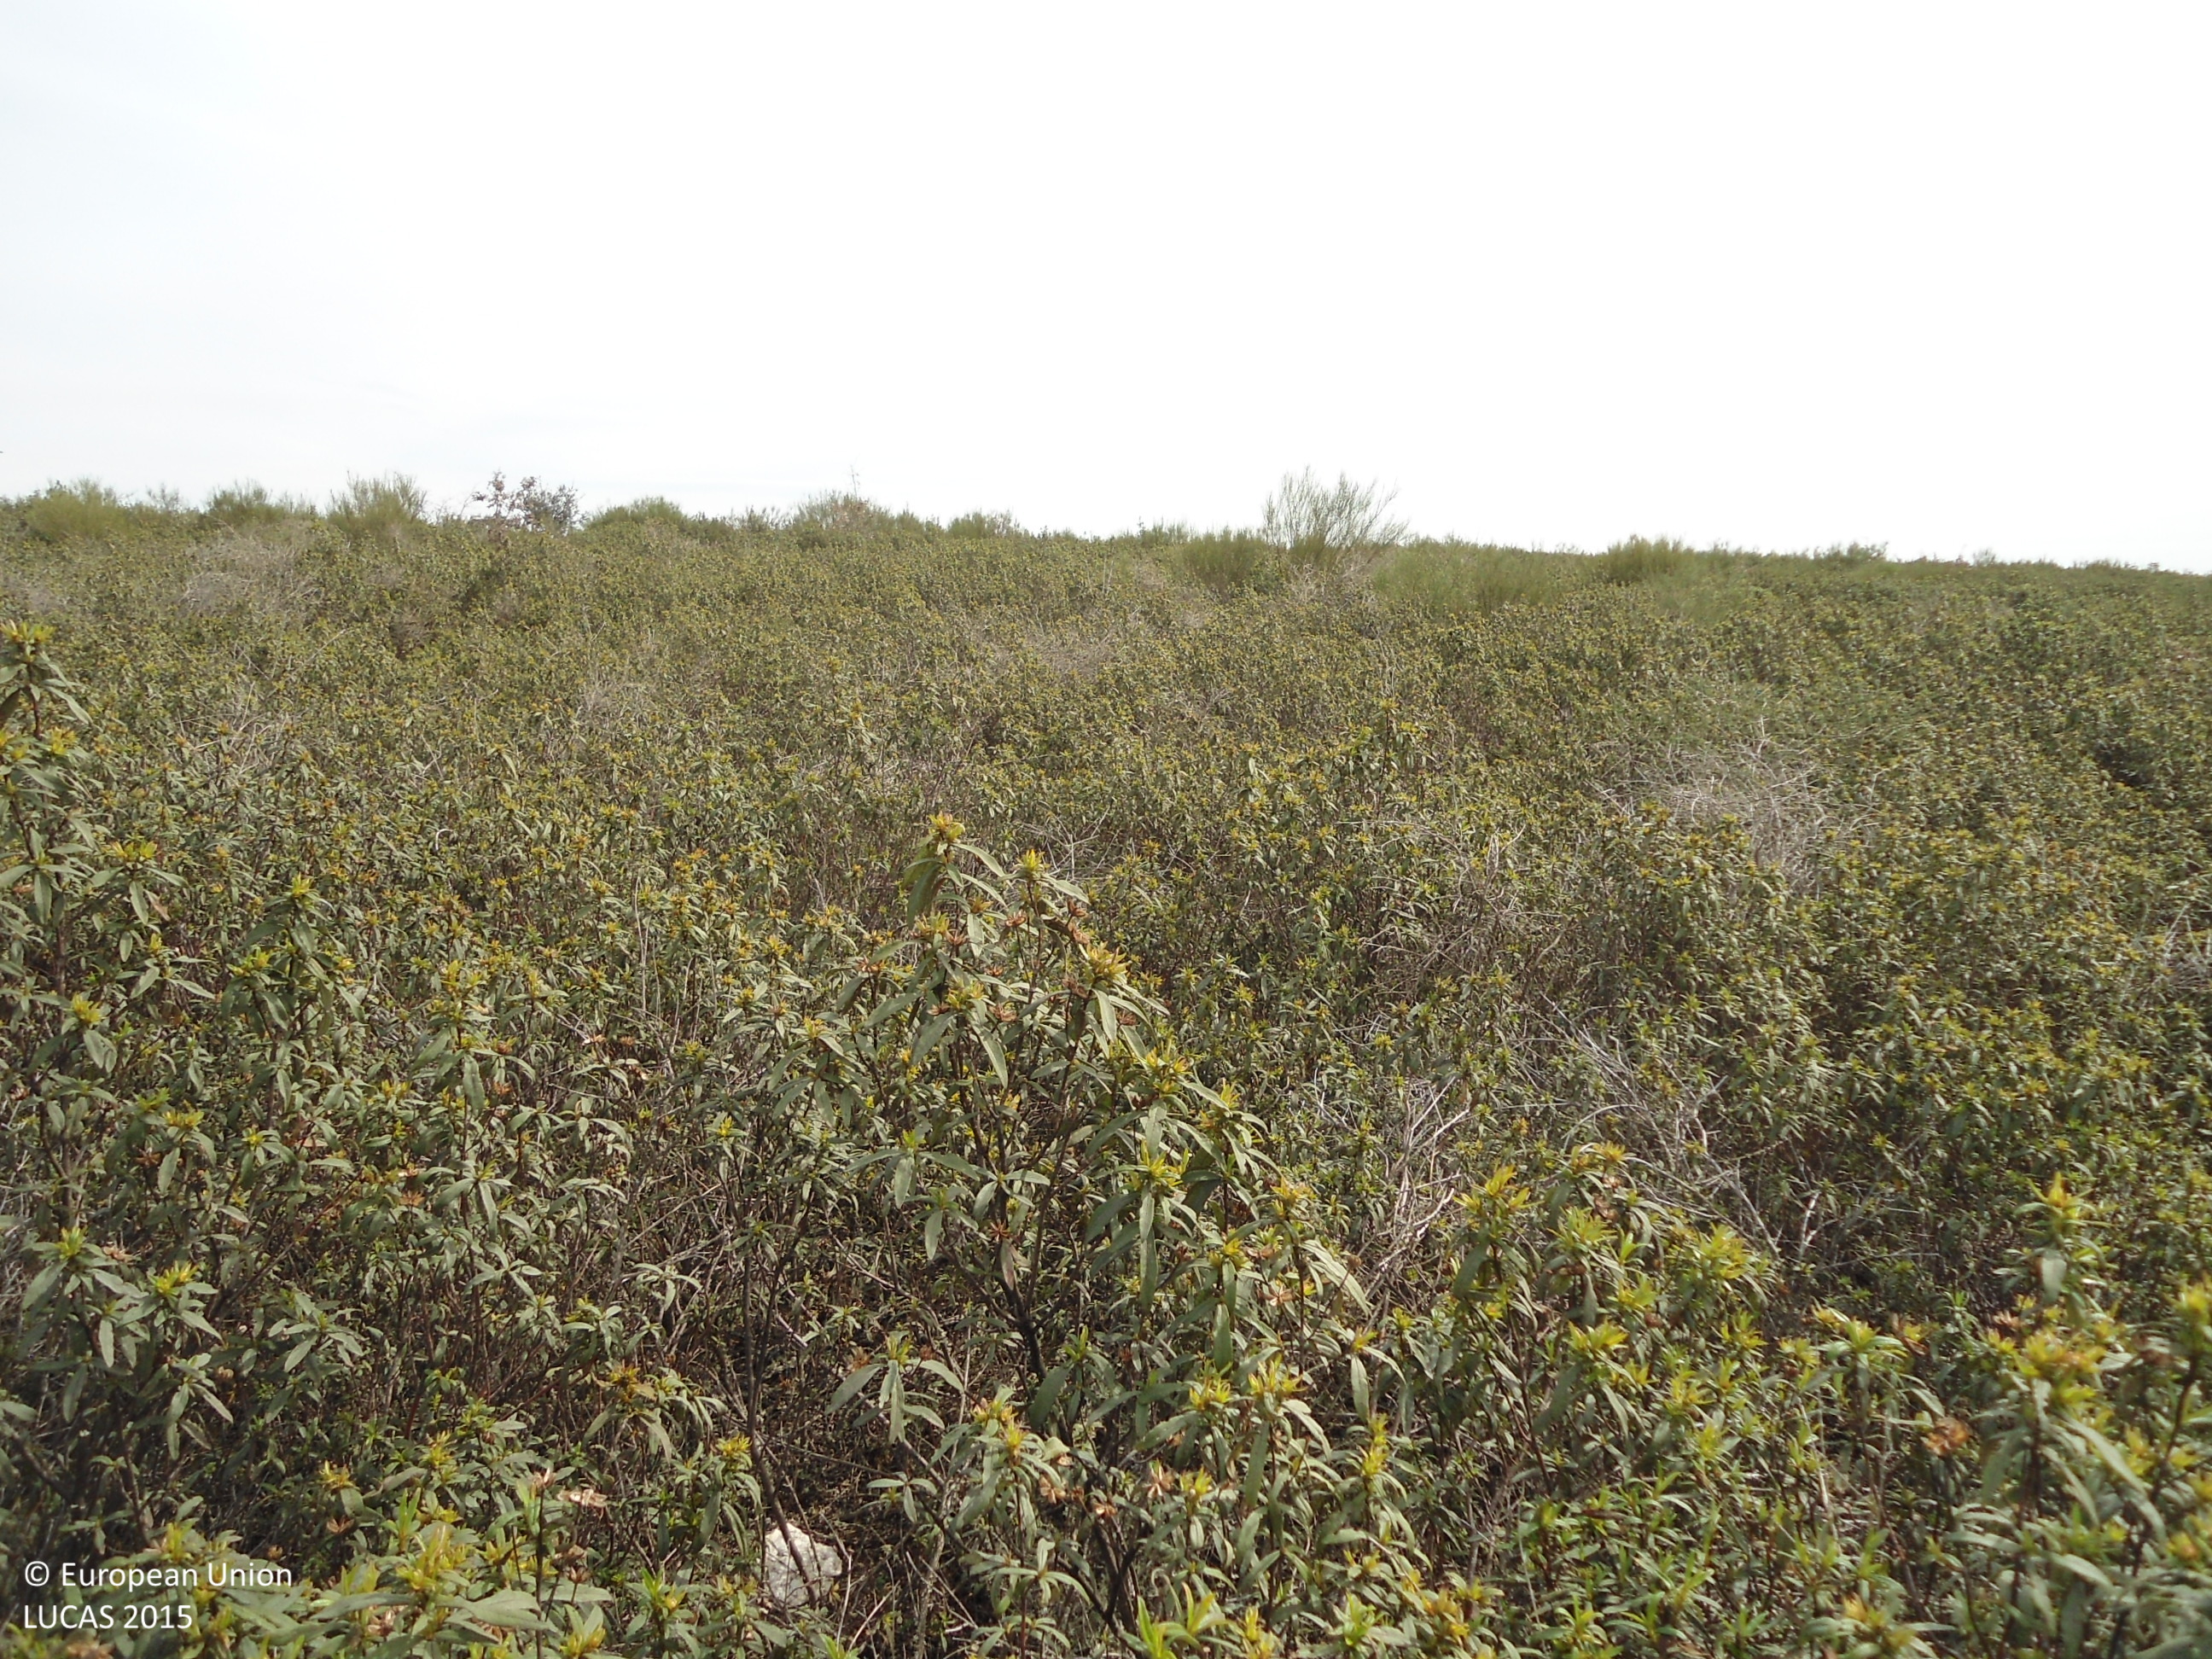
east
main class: Shrubland
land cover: Shrubland with sparse tree cover
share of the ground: > 75 %
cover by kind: shrubs 95 %, broadleaved forest trees 5 %
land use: Semi-natural and natural areas not in use
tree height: < 5 m
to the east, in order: Shrubland with sparse tree cover; Shrubland without tree cover; Tracks; Shrubland without tree cover; Tracks; Shrubland without tree cover; Tracks; Shrubland without tree cover
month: April
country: ES
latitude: 41.6285
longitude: -6.1204
